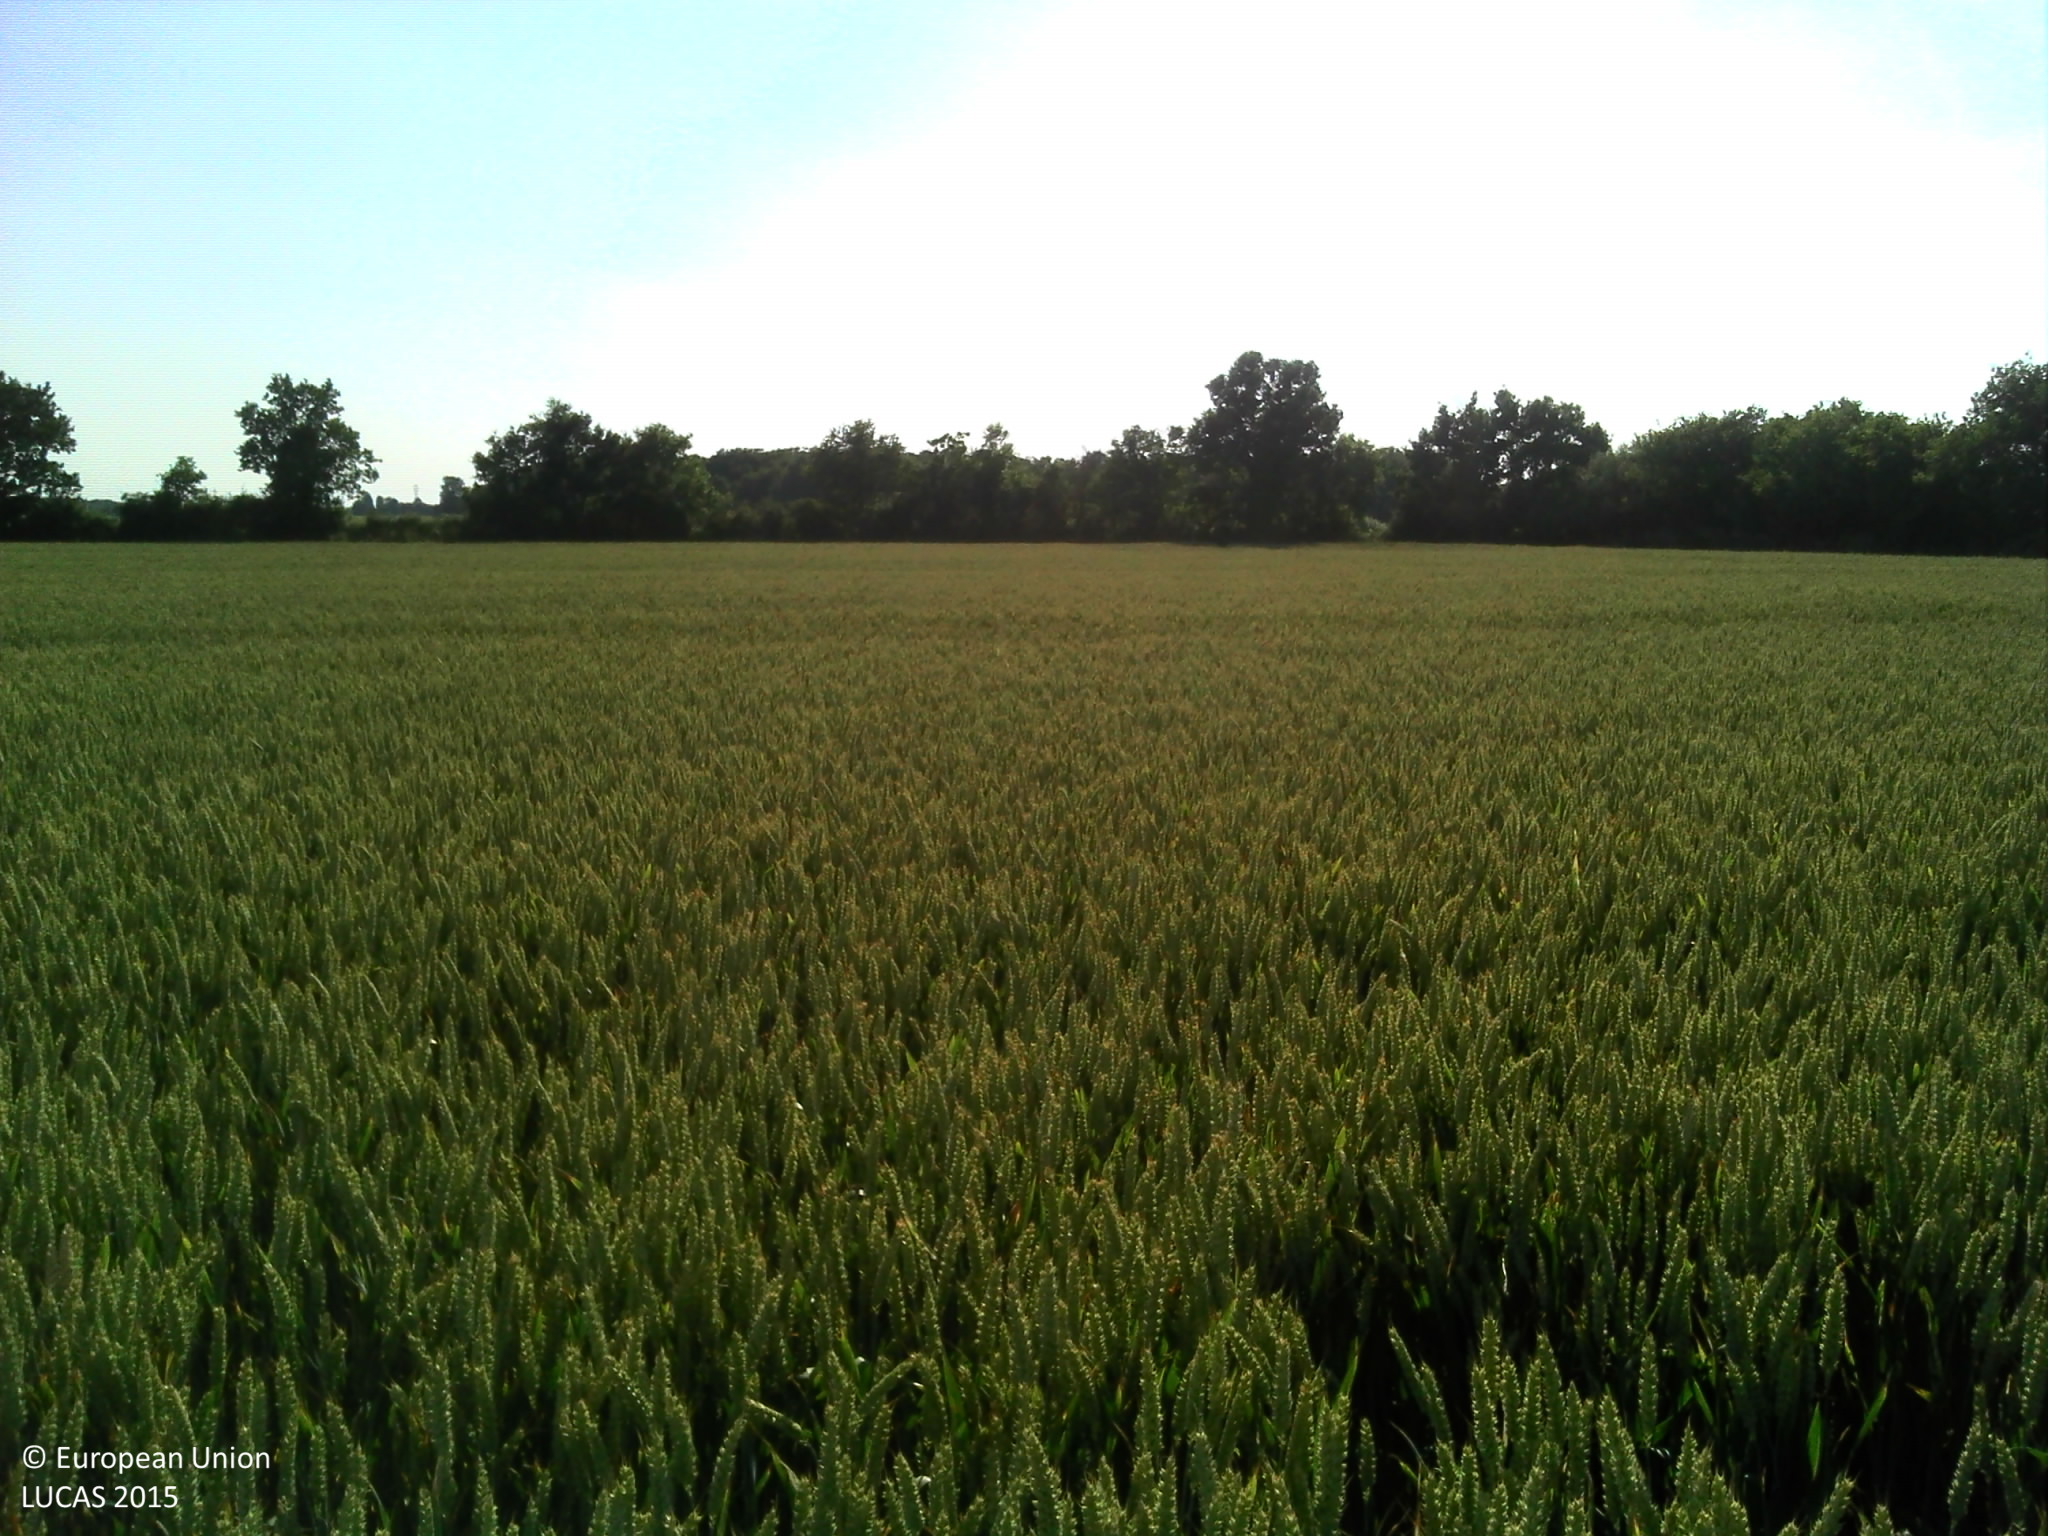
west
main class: Cropland
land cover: Common wheat
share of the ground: > 75 %
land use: Agriculture (excluding fallow land and kitchen gardens)
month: June
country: FR
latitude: 46.8887
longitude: -1.3641
